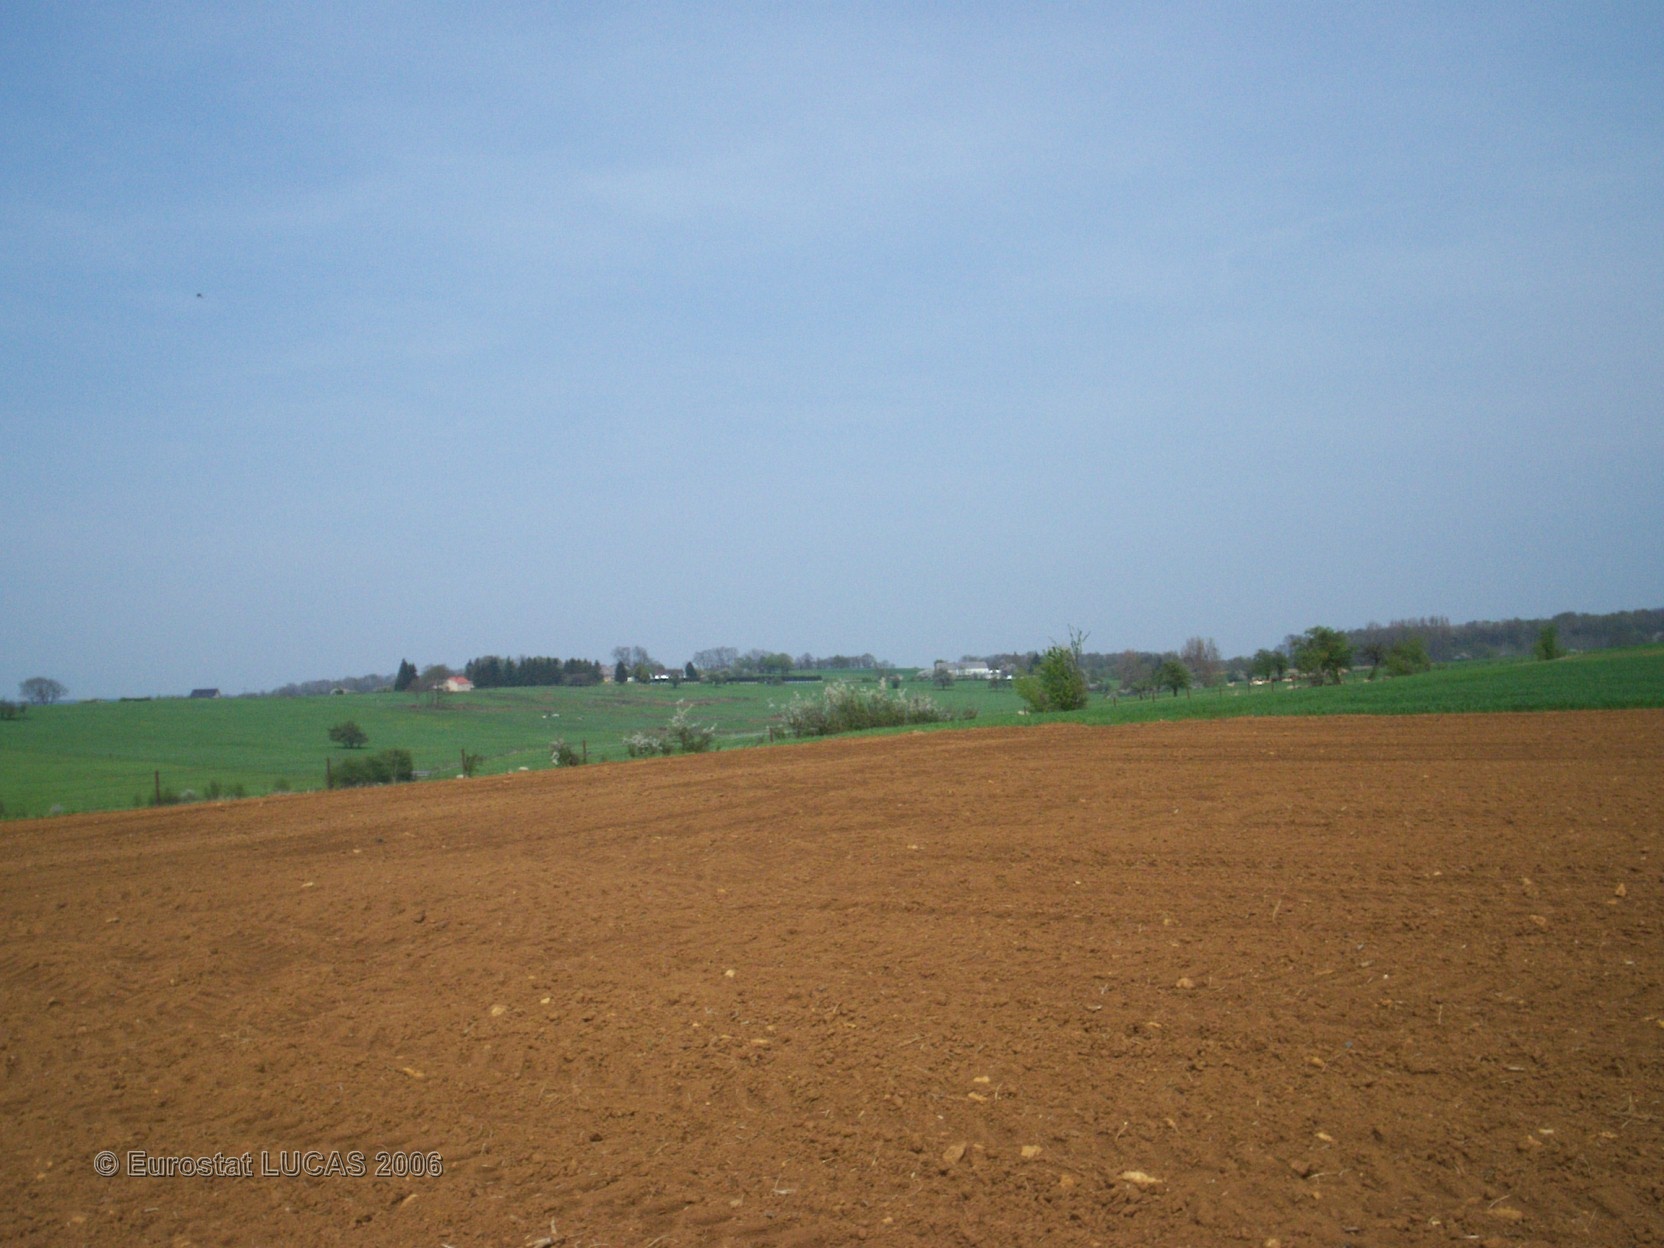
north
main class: Cropland
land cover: Maize
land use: Agriculture (excluding fallow land and kitchen gardens)
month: May
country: FR
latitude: 49.8631
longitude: 4.3336
